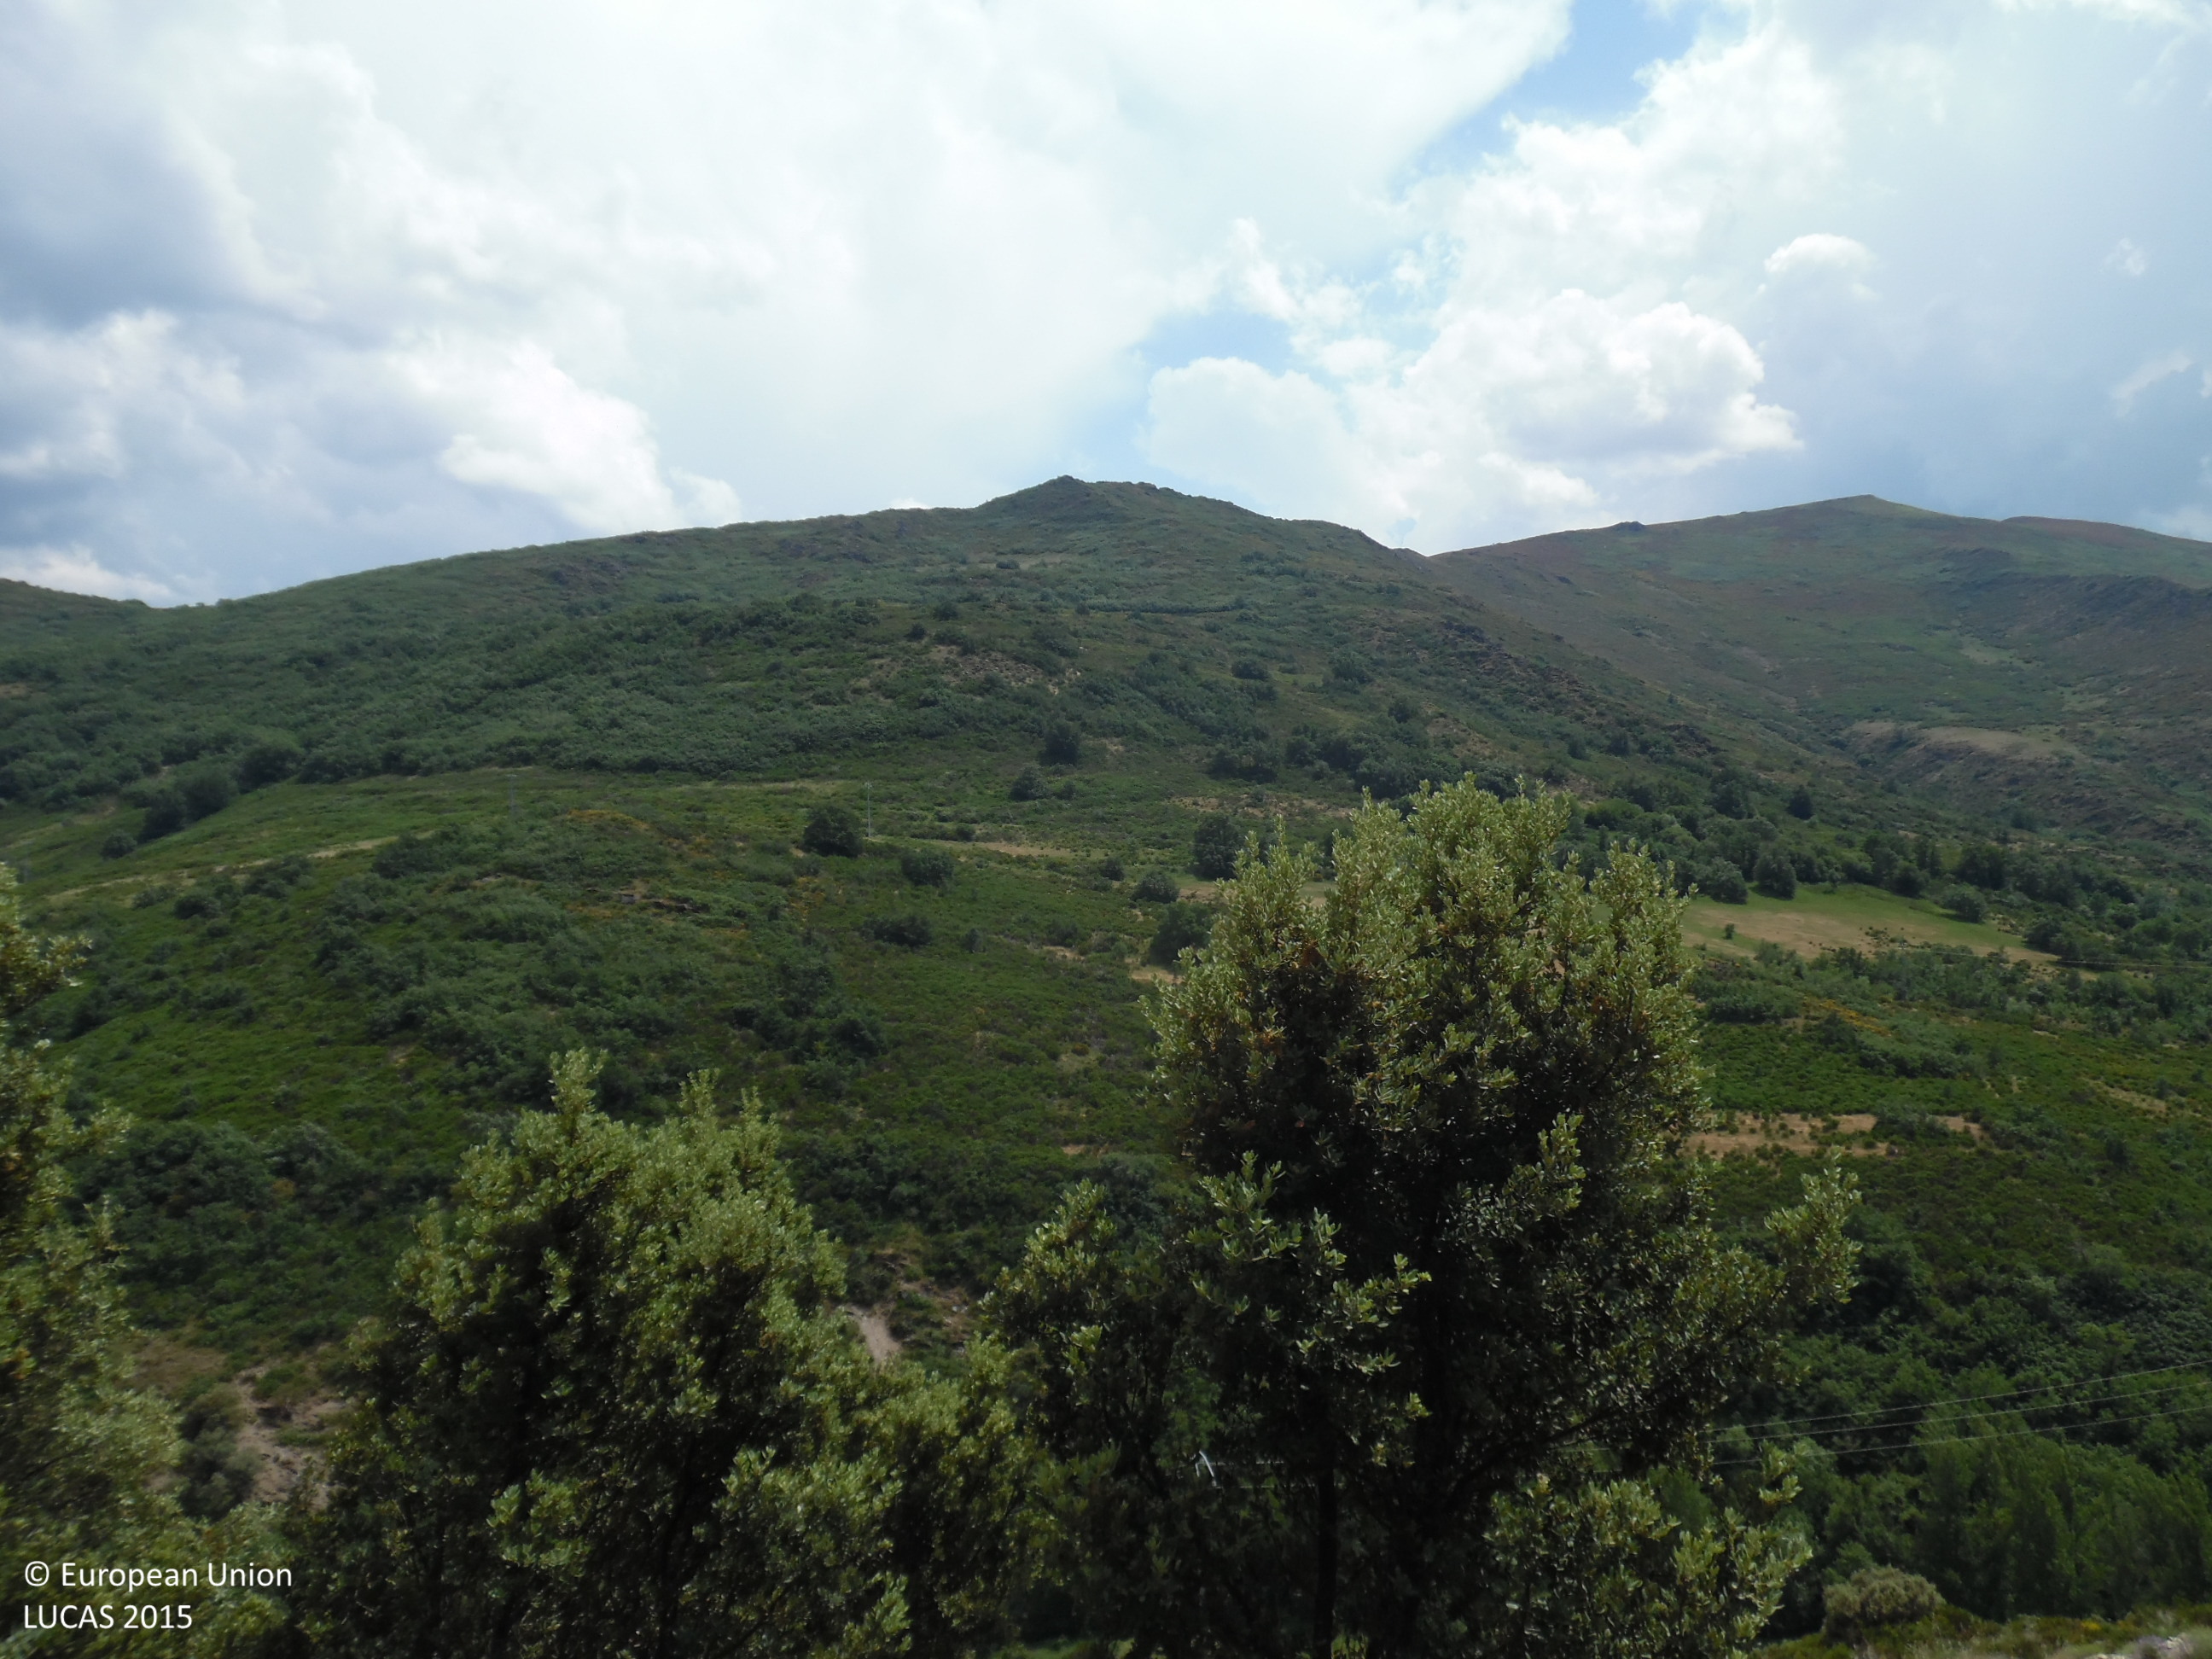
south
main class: Woodland
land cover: Broadleaved woodland
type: broadleaved evergreen forest
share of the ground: > 75 %
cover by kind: broadleaved forest trees 95 %, shrubs 5 %
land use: Forestry
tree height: > 5 m
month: June
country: ES
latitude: 42.2639
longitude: -6.6156
